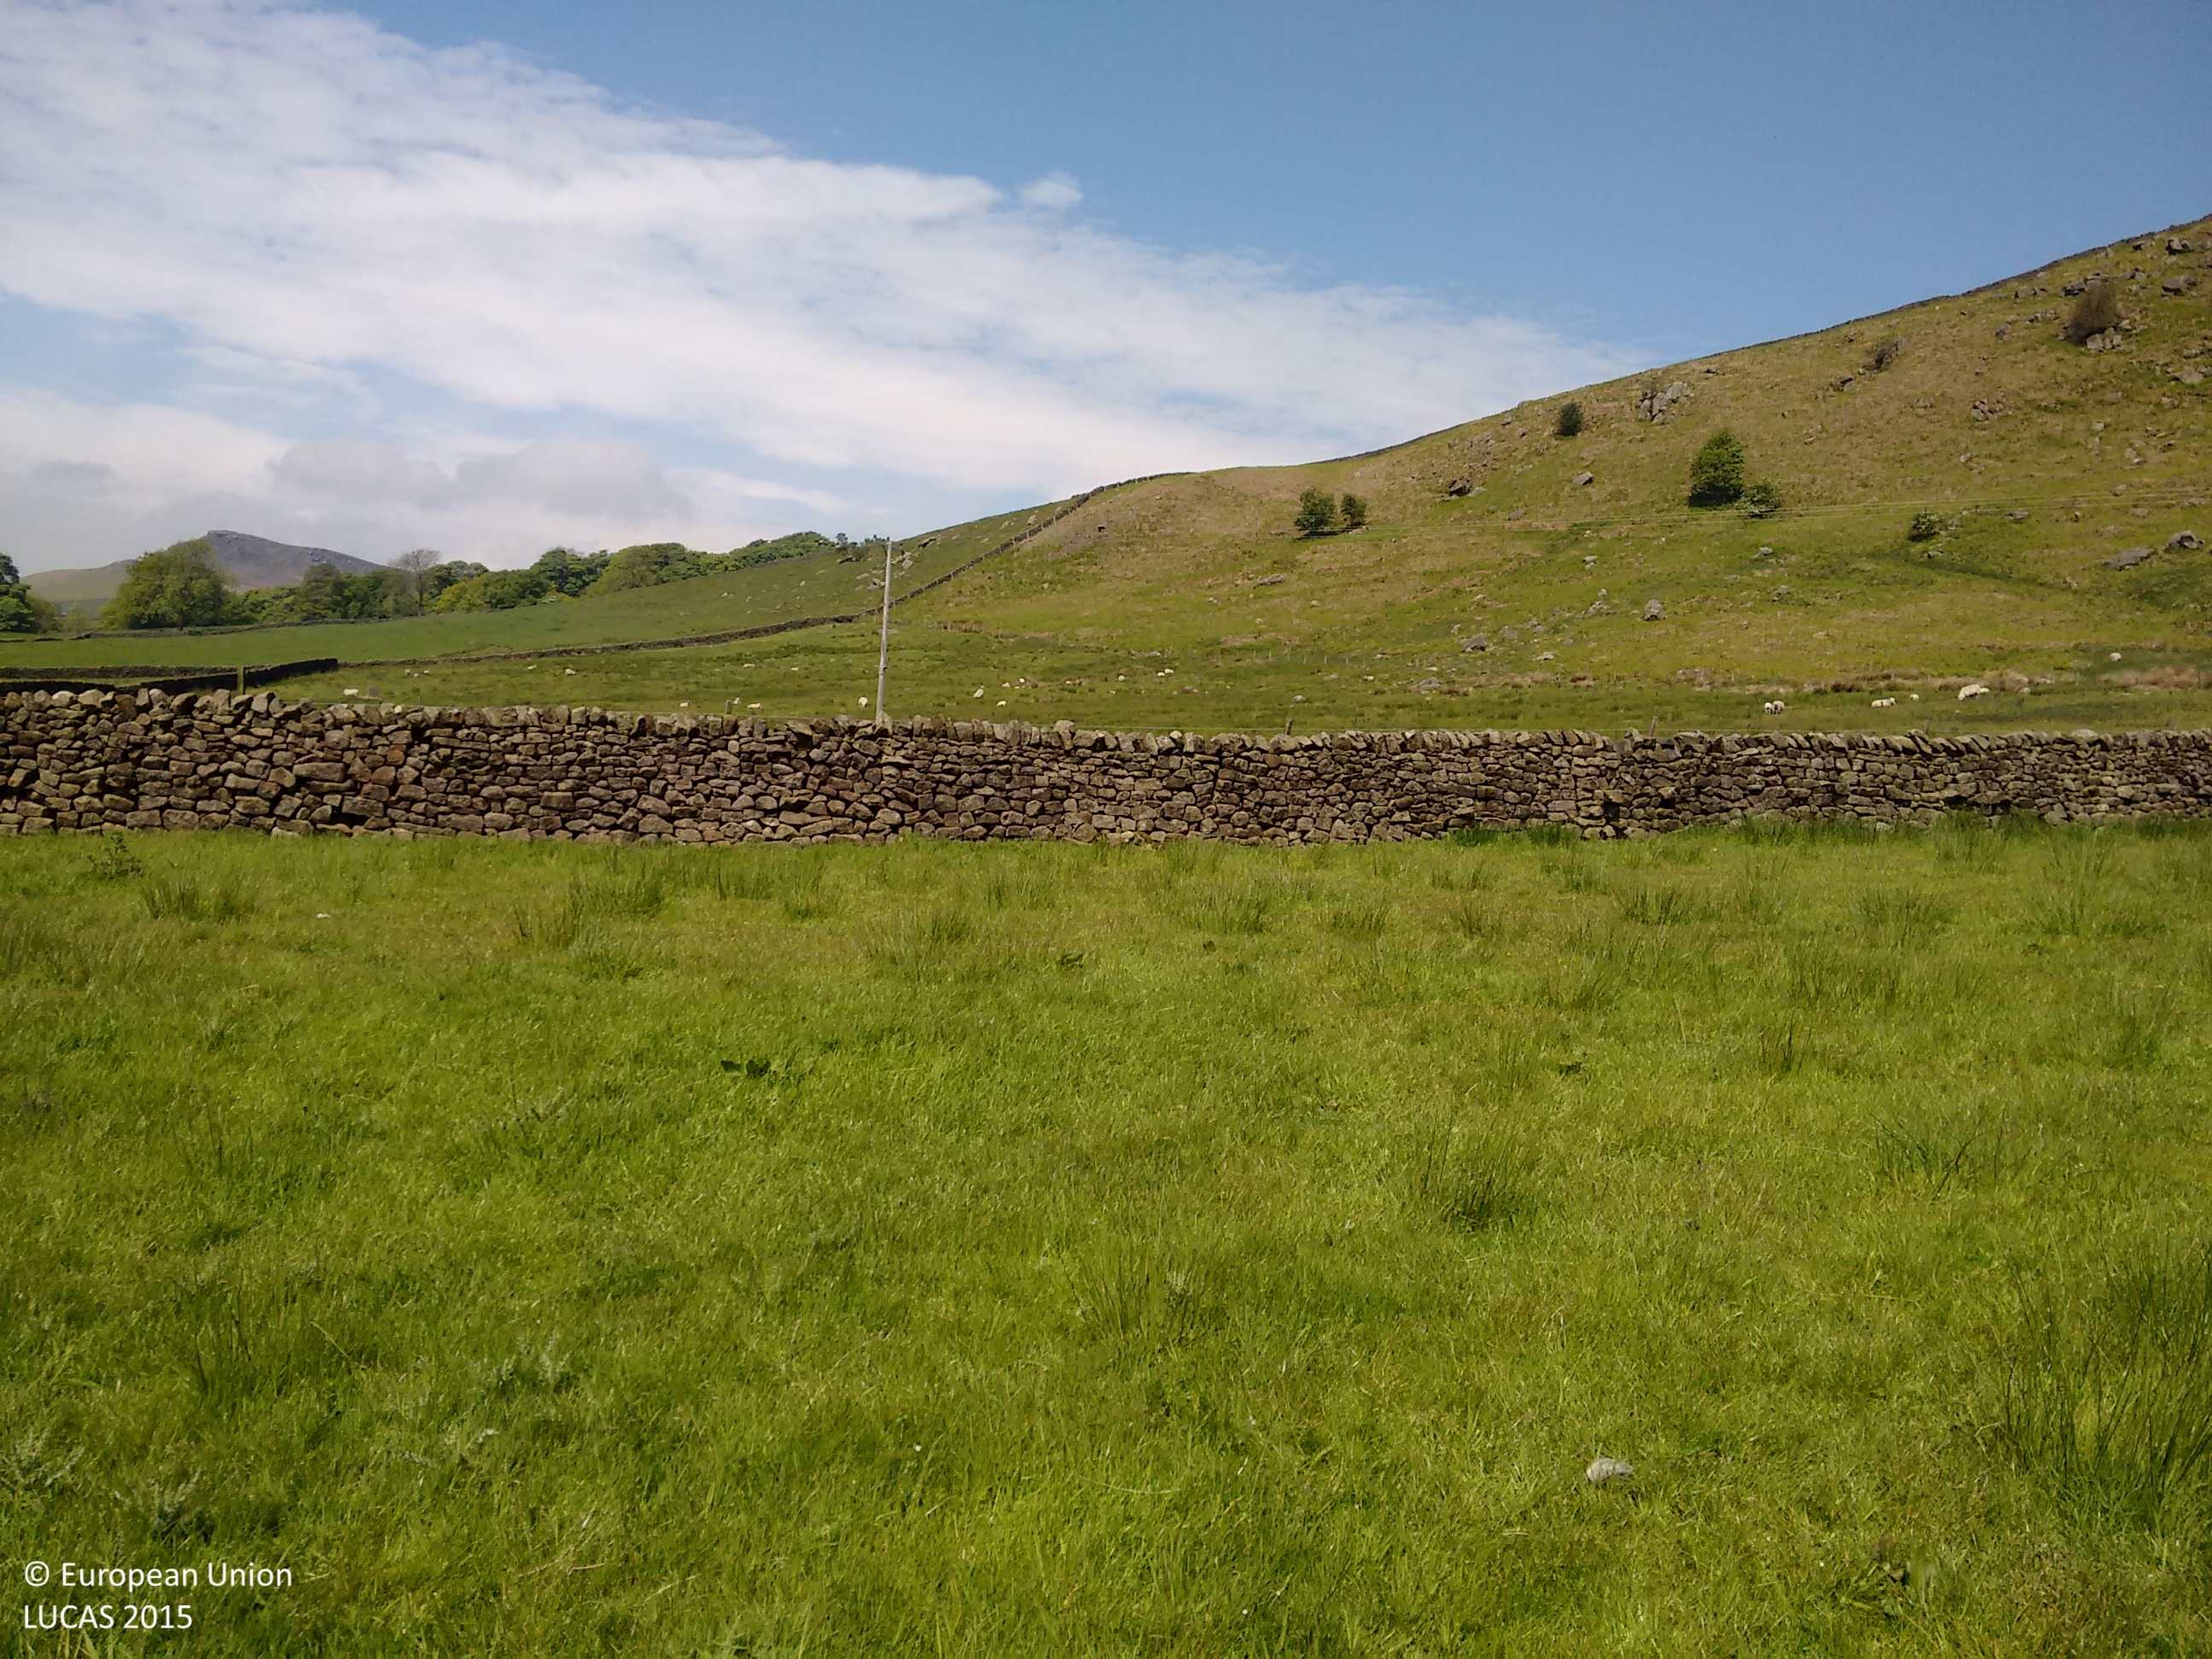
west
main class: Grassland
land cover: Grassland without tree/shrub cover
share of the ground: > 75 %
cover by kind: herbaceous plants 100 %
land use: Agriculture (excluding fallow land and kitchen gardens)
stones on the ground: < 10 %
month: June
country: GB
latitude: 53.9880
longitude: -1.9675
